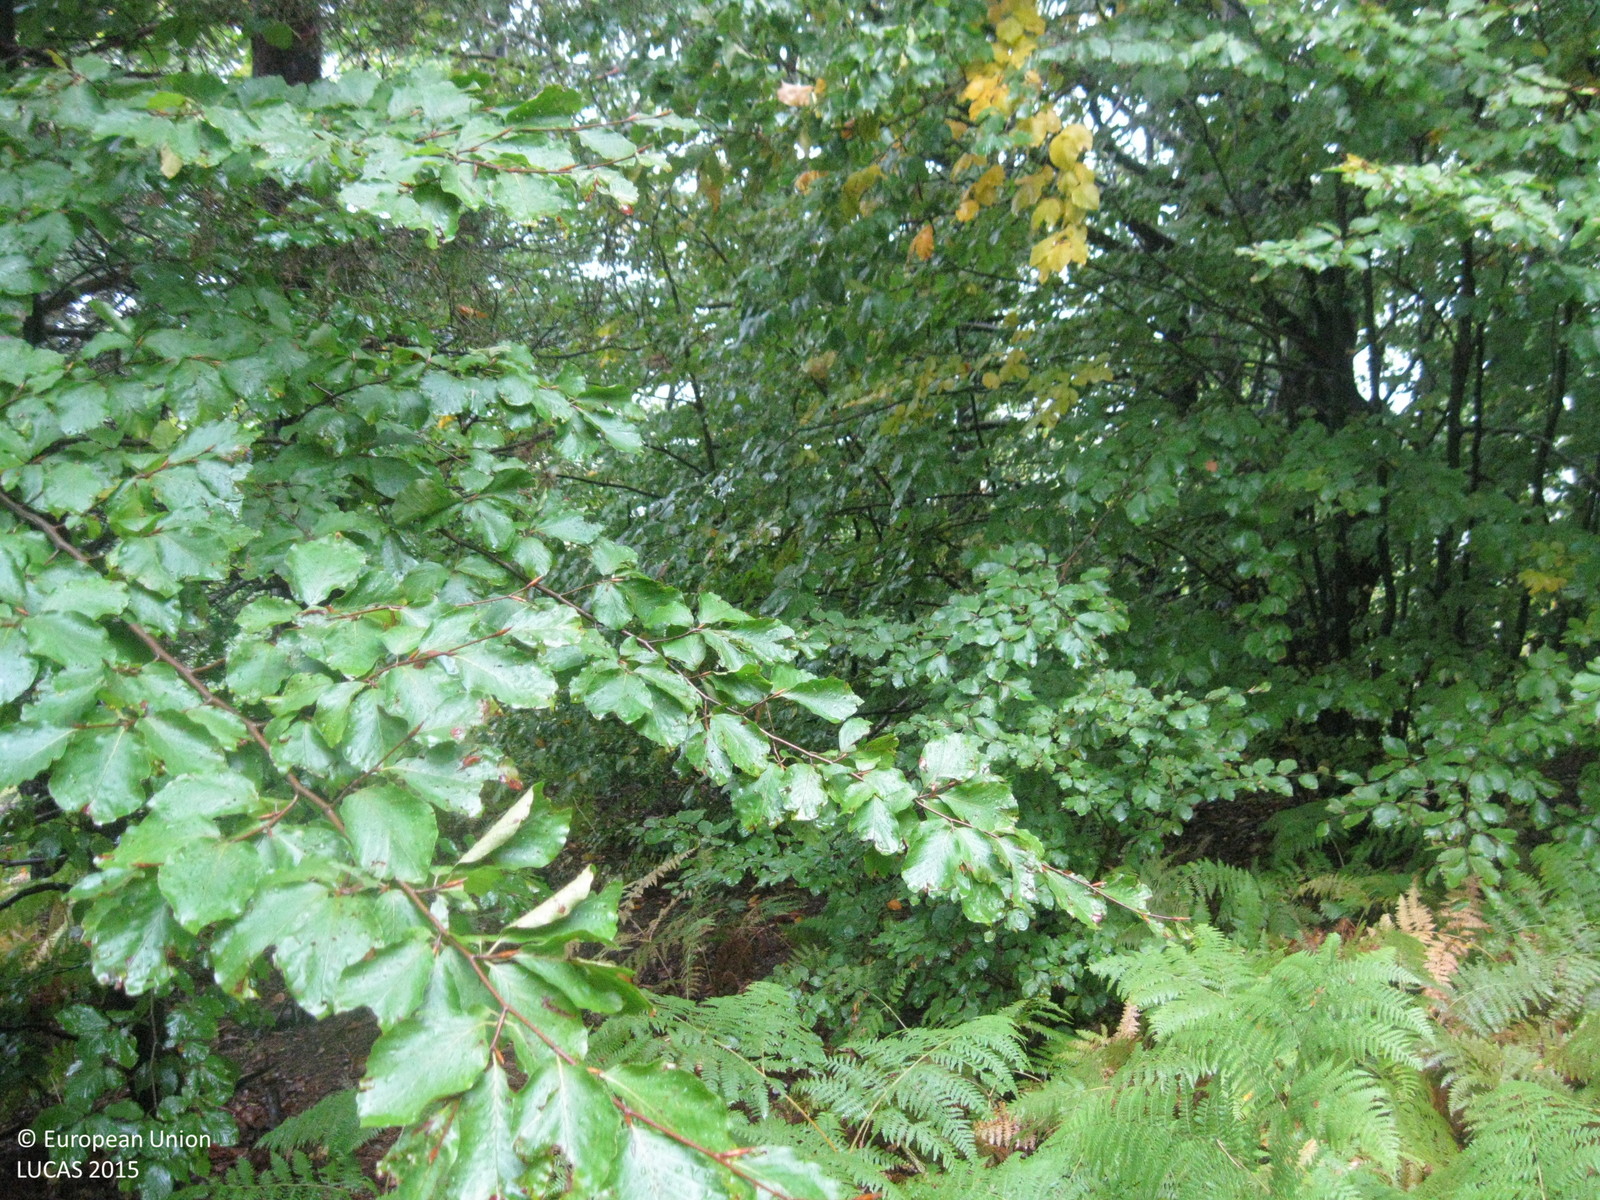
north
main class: Woodland
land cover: Broadleaved woodland
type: mesophytic deciduous forest
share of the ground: > 75 %
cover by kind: broadleaved forest trees 95 %, shrubs 5 %
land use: Forestry
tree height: > 5 m
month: October
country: BG
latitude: 41.8418
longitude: 24.9977
